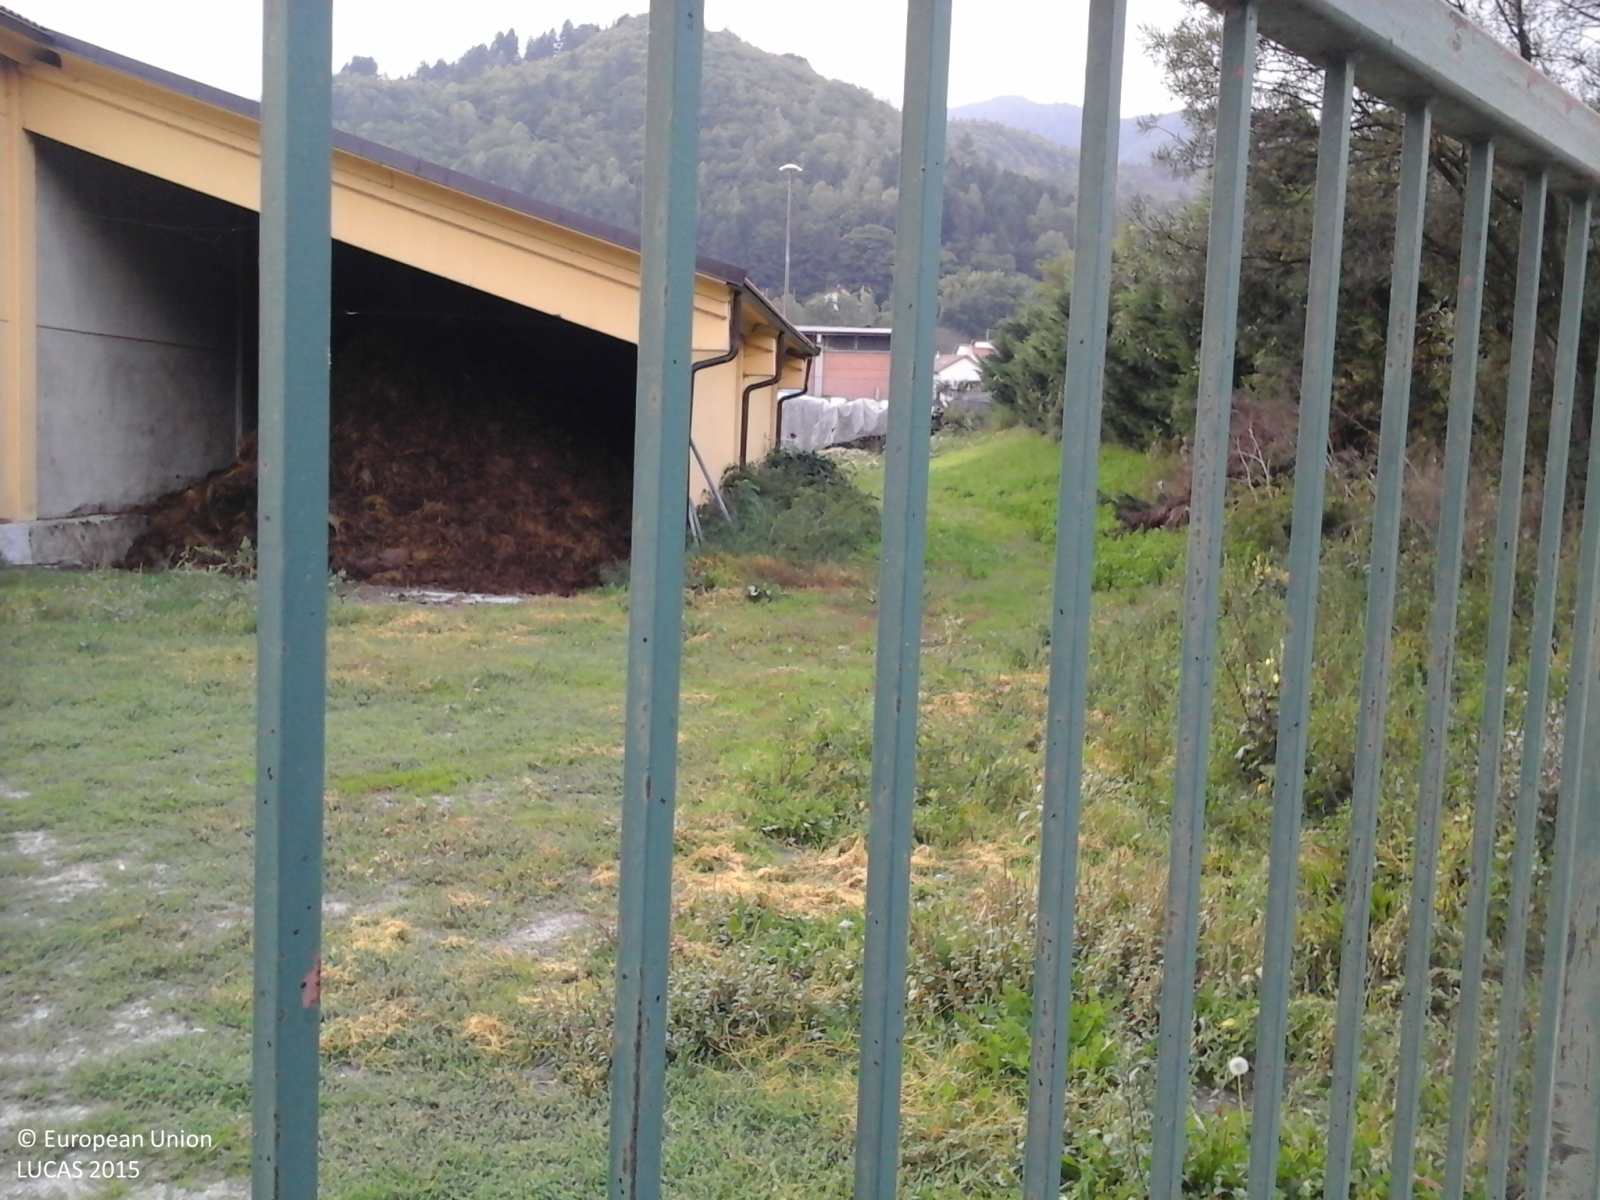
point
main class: Grassland
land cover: Spontaneously vegetated surfaces
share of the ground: > 75 %
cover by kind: herbaceous plants 100 %
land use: Agriculture (excluding fallow land and kitchen gardens)
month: September
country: IT
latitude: 44.2432
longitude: 8.1134
